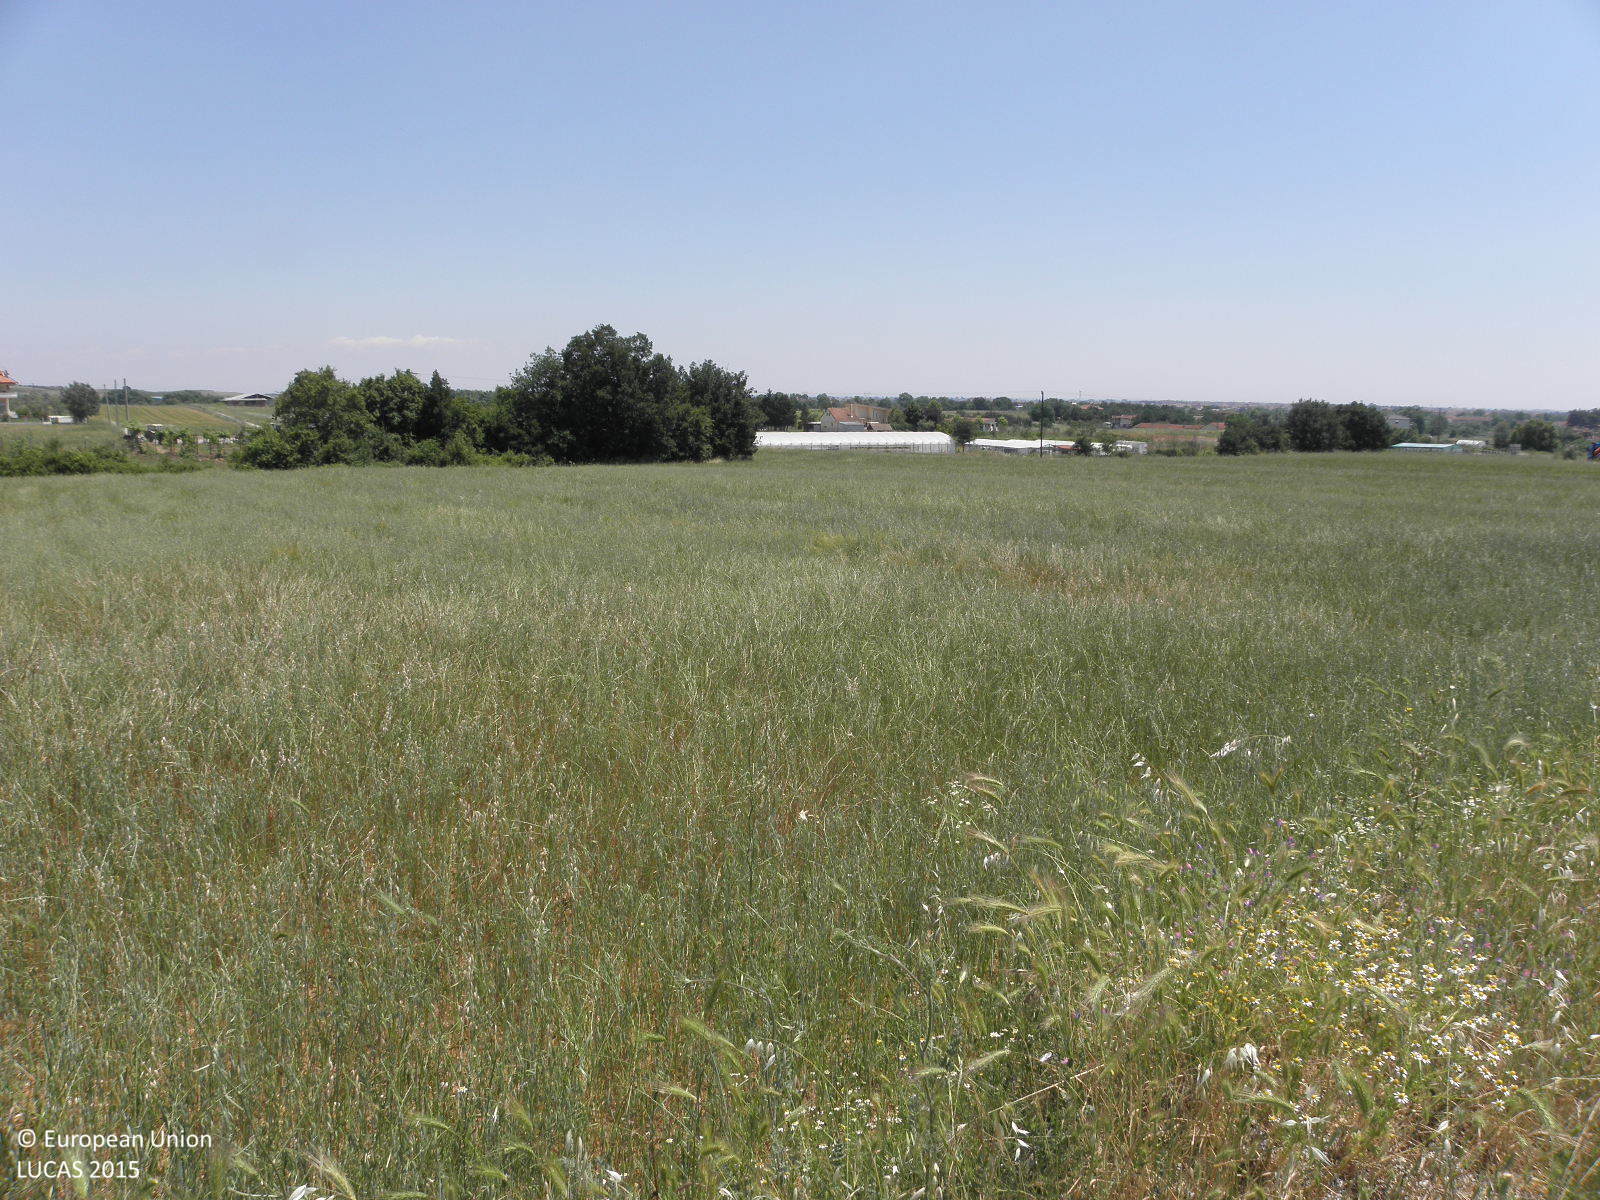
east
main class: Cropland
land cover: Barley
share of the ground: > 75 %
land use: Agriculture (excluding fallow land and kitchen gardens)
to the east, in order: Grass margins; Barley; Broadleaved woodland; Artificial constructions; Fences; Electric lines; Olive groves; Fences; Spontaneously vegetated surfaces
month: May
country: GR
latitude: 40.2929
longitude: 22.4556
